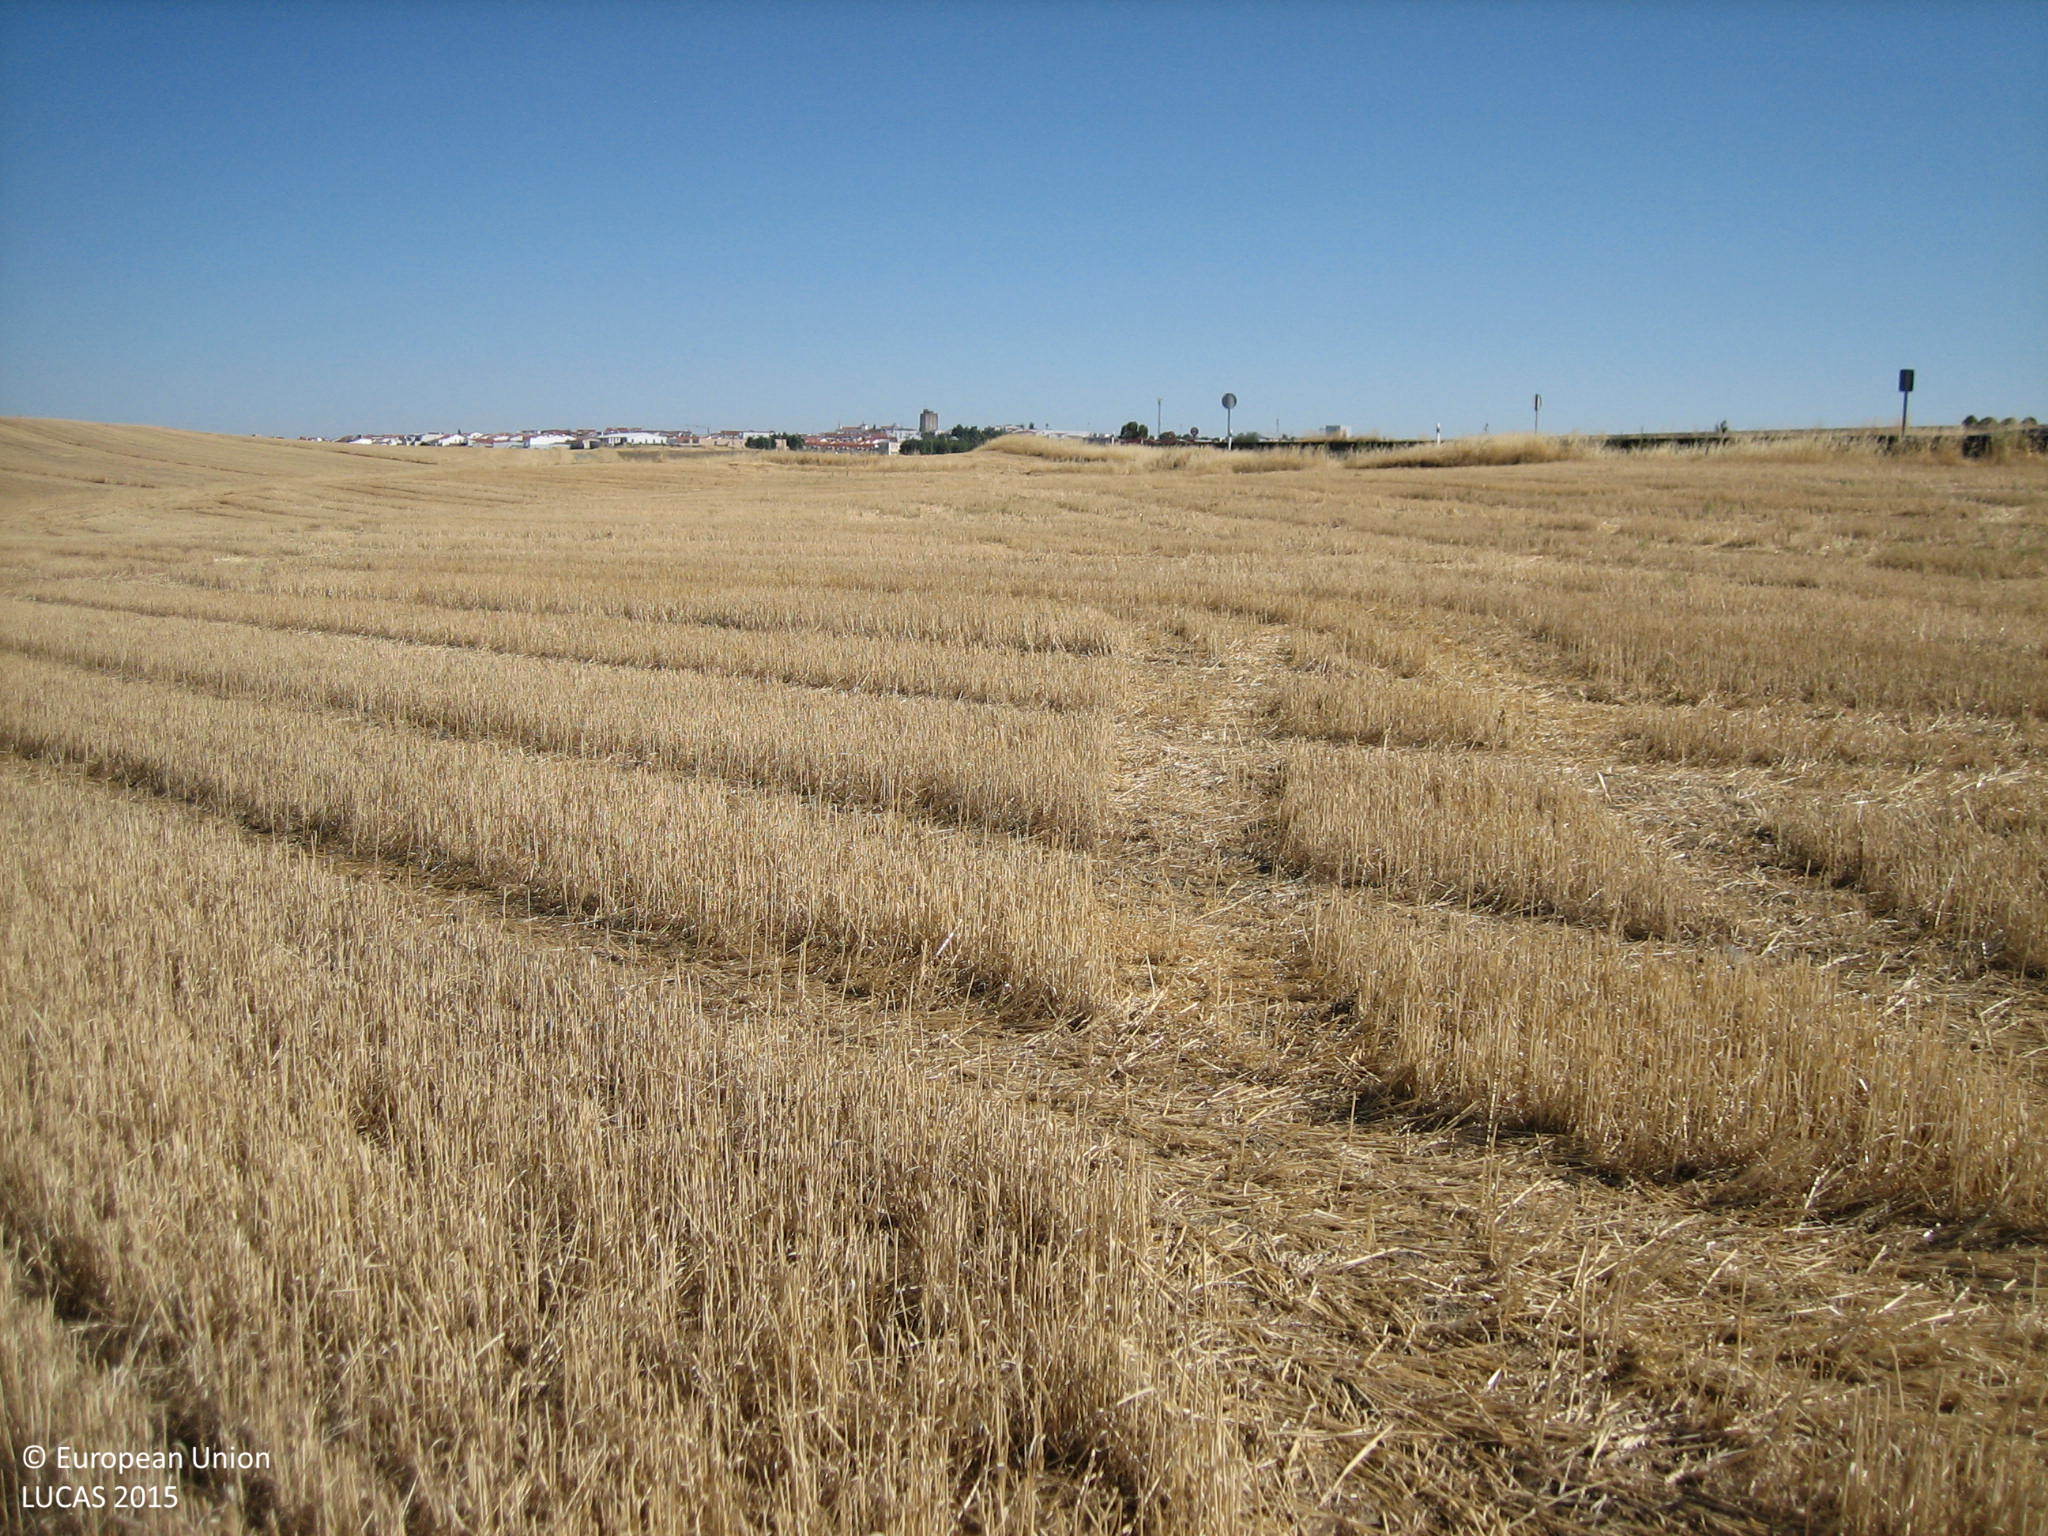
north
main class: Cropland
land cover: Common wheat
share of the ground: < 10 %
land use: Agriculture (excluding fallow land and kitchen gardens)
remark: Harvested field
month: July
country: ES
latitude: 38.2304
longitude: -6.3008
